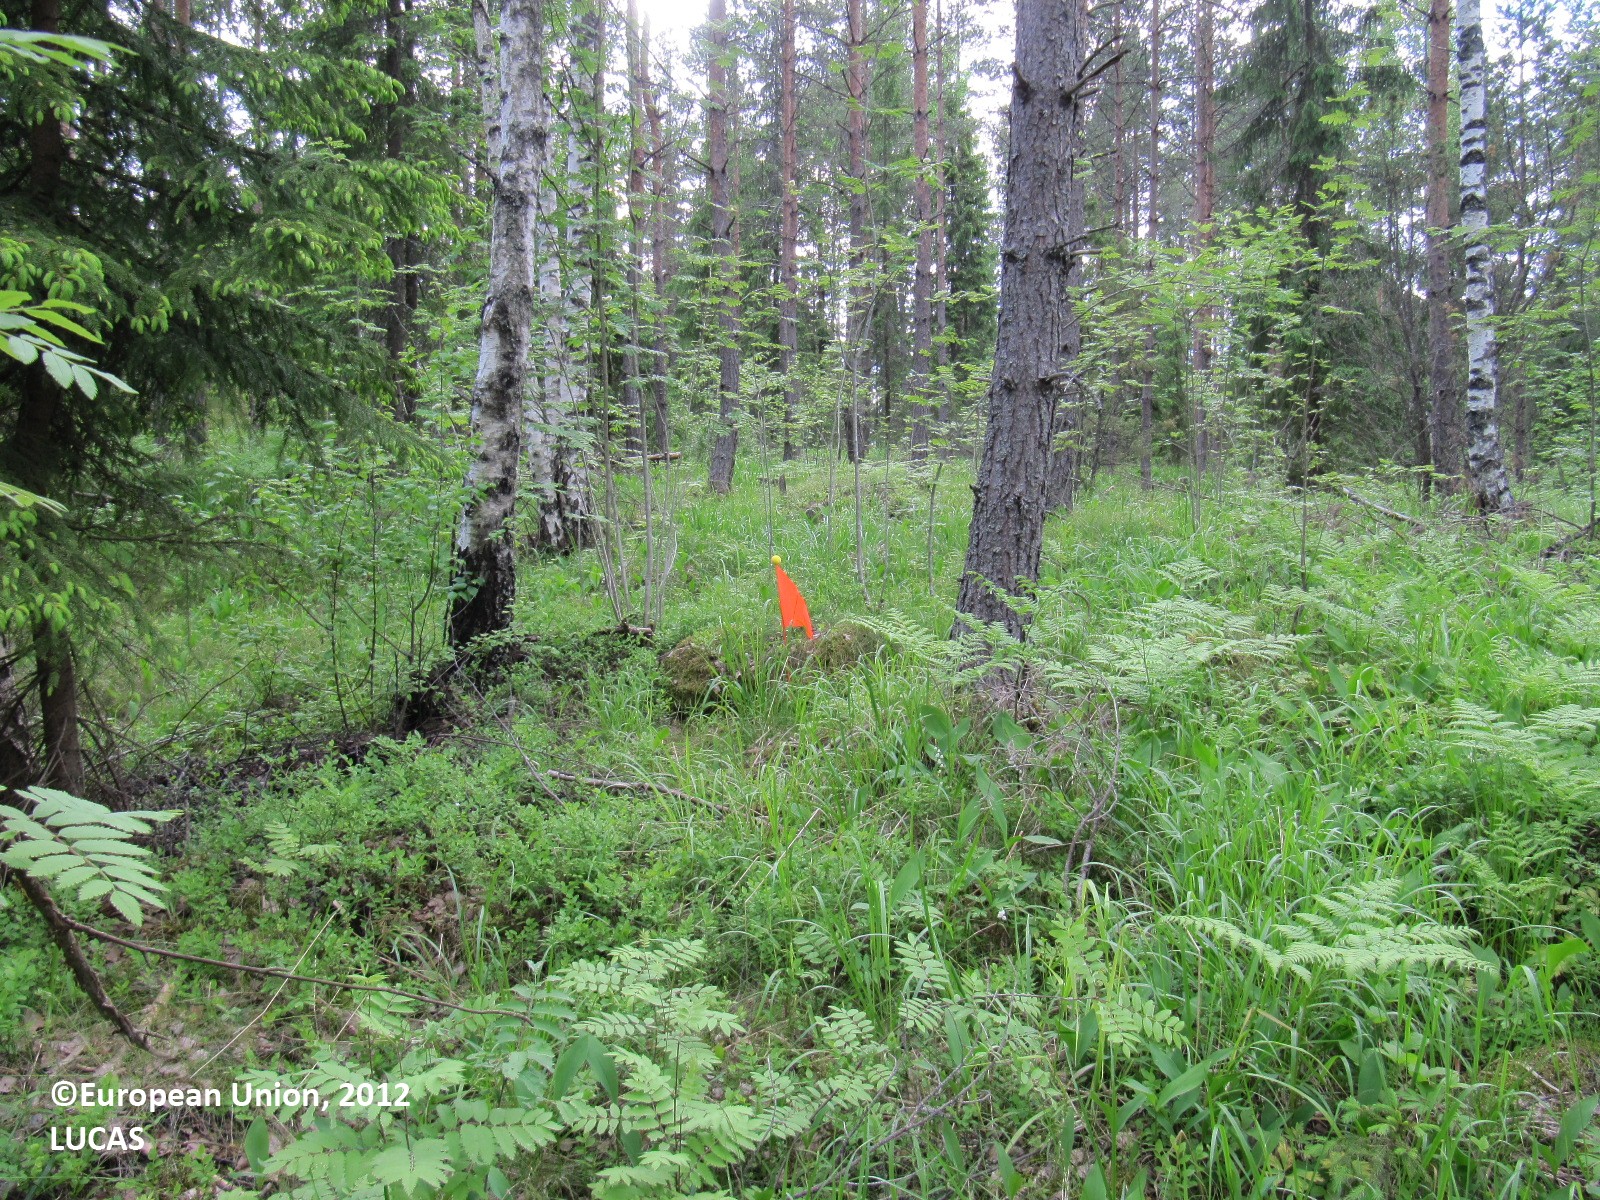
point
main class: Woodland
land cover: Pine dominated mixed woodland
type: boreal forest
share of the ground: 50 - 75 %
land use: Forestry
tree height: > 5 m
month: June
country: FI
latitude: 60.3077
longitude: 24.3110
